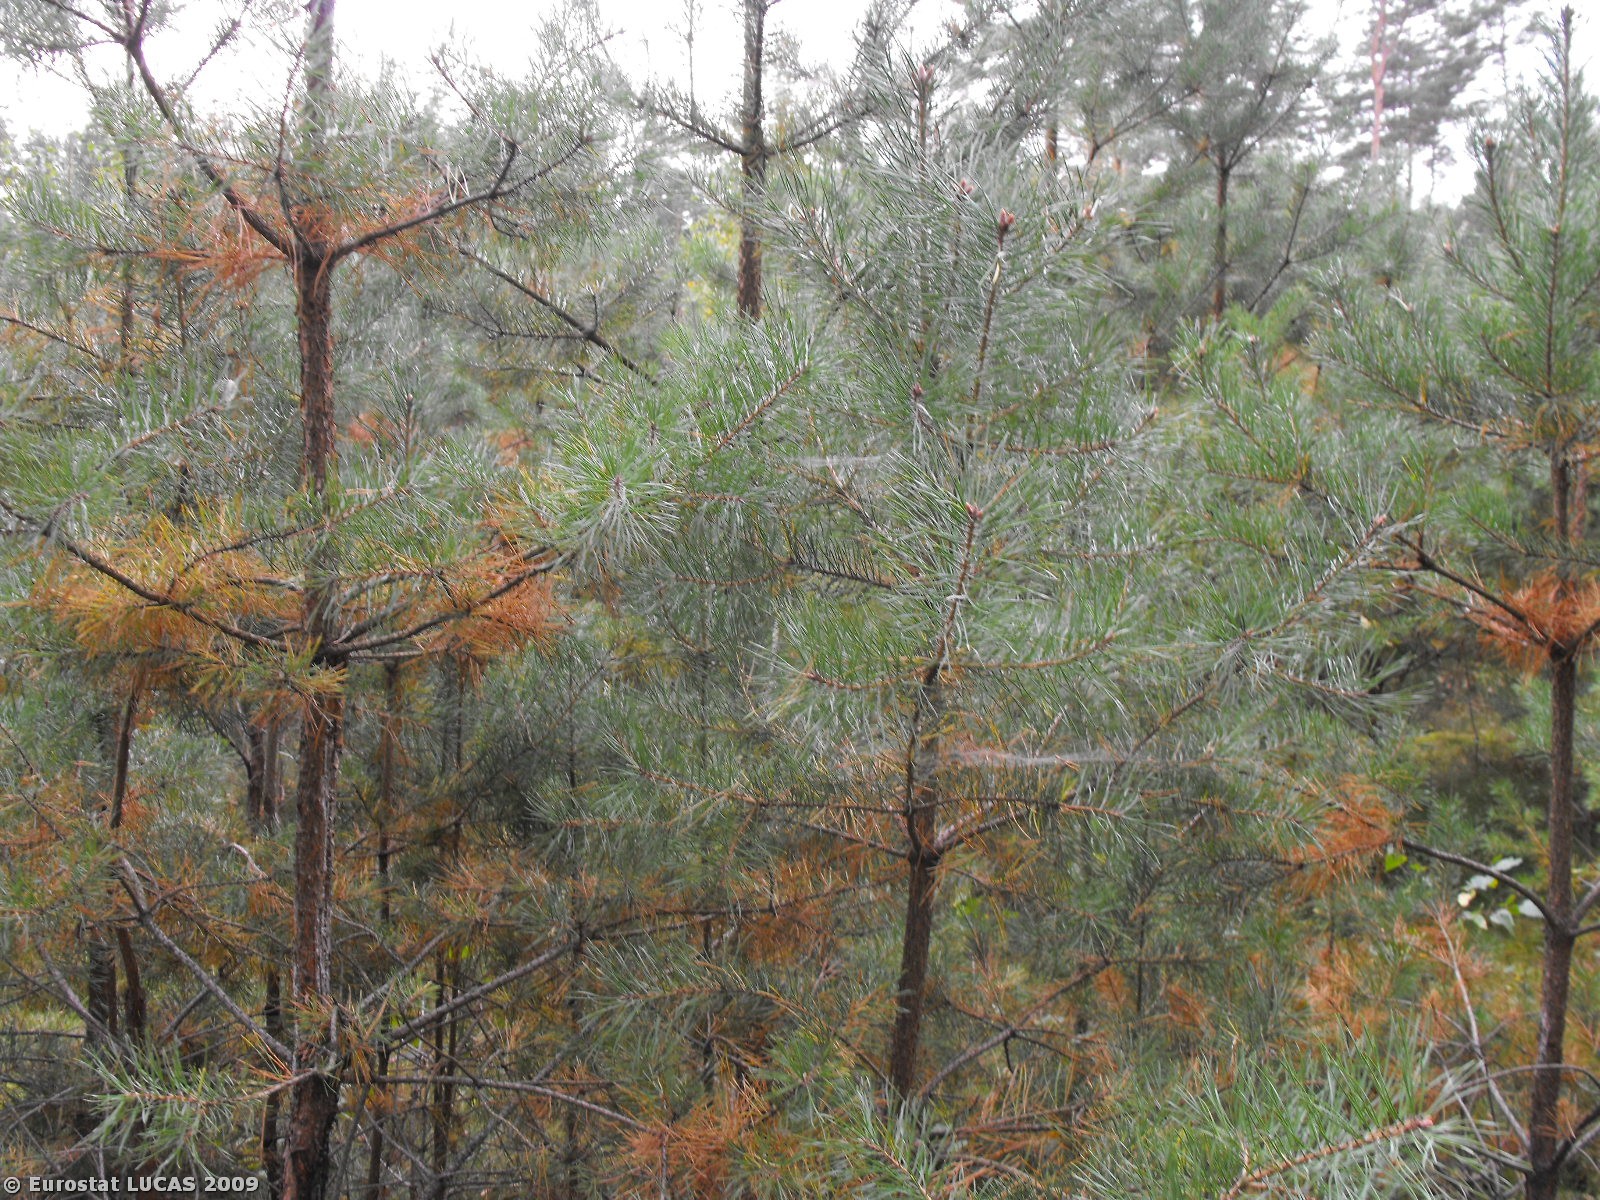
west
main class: Woodland
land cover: Coniferous woodland
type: hemiboreal forest and nemoral coniferous forest and mixed broadleaved-coniferous forest
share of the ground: > 75 %
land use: Forestry
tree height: > 5 m
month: September
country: PL
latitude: 53.0046
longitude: 16.2801
